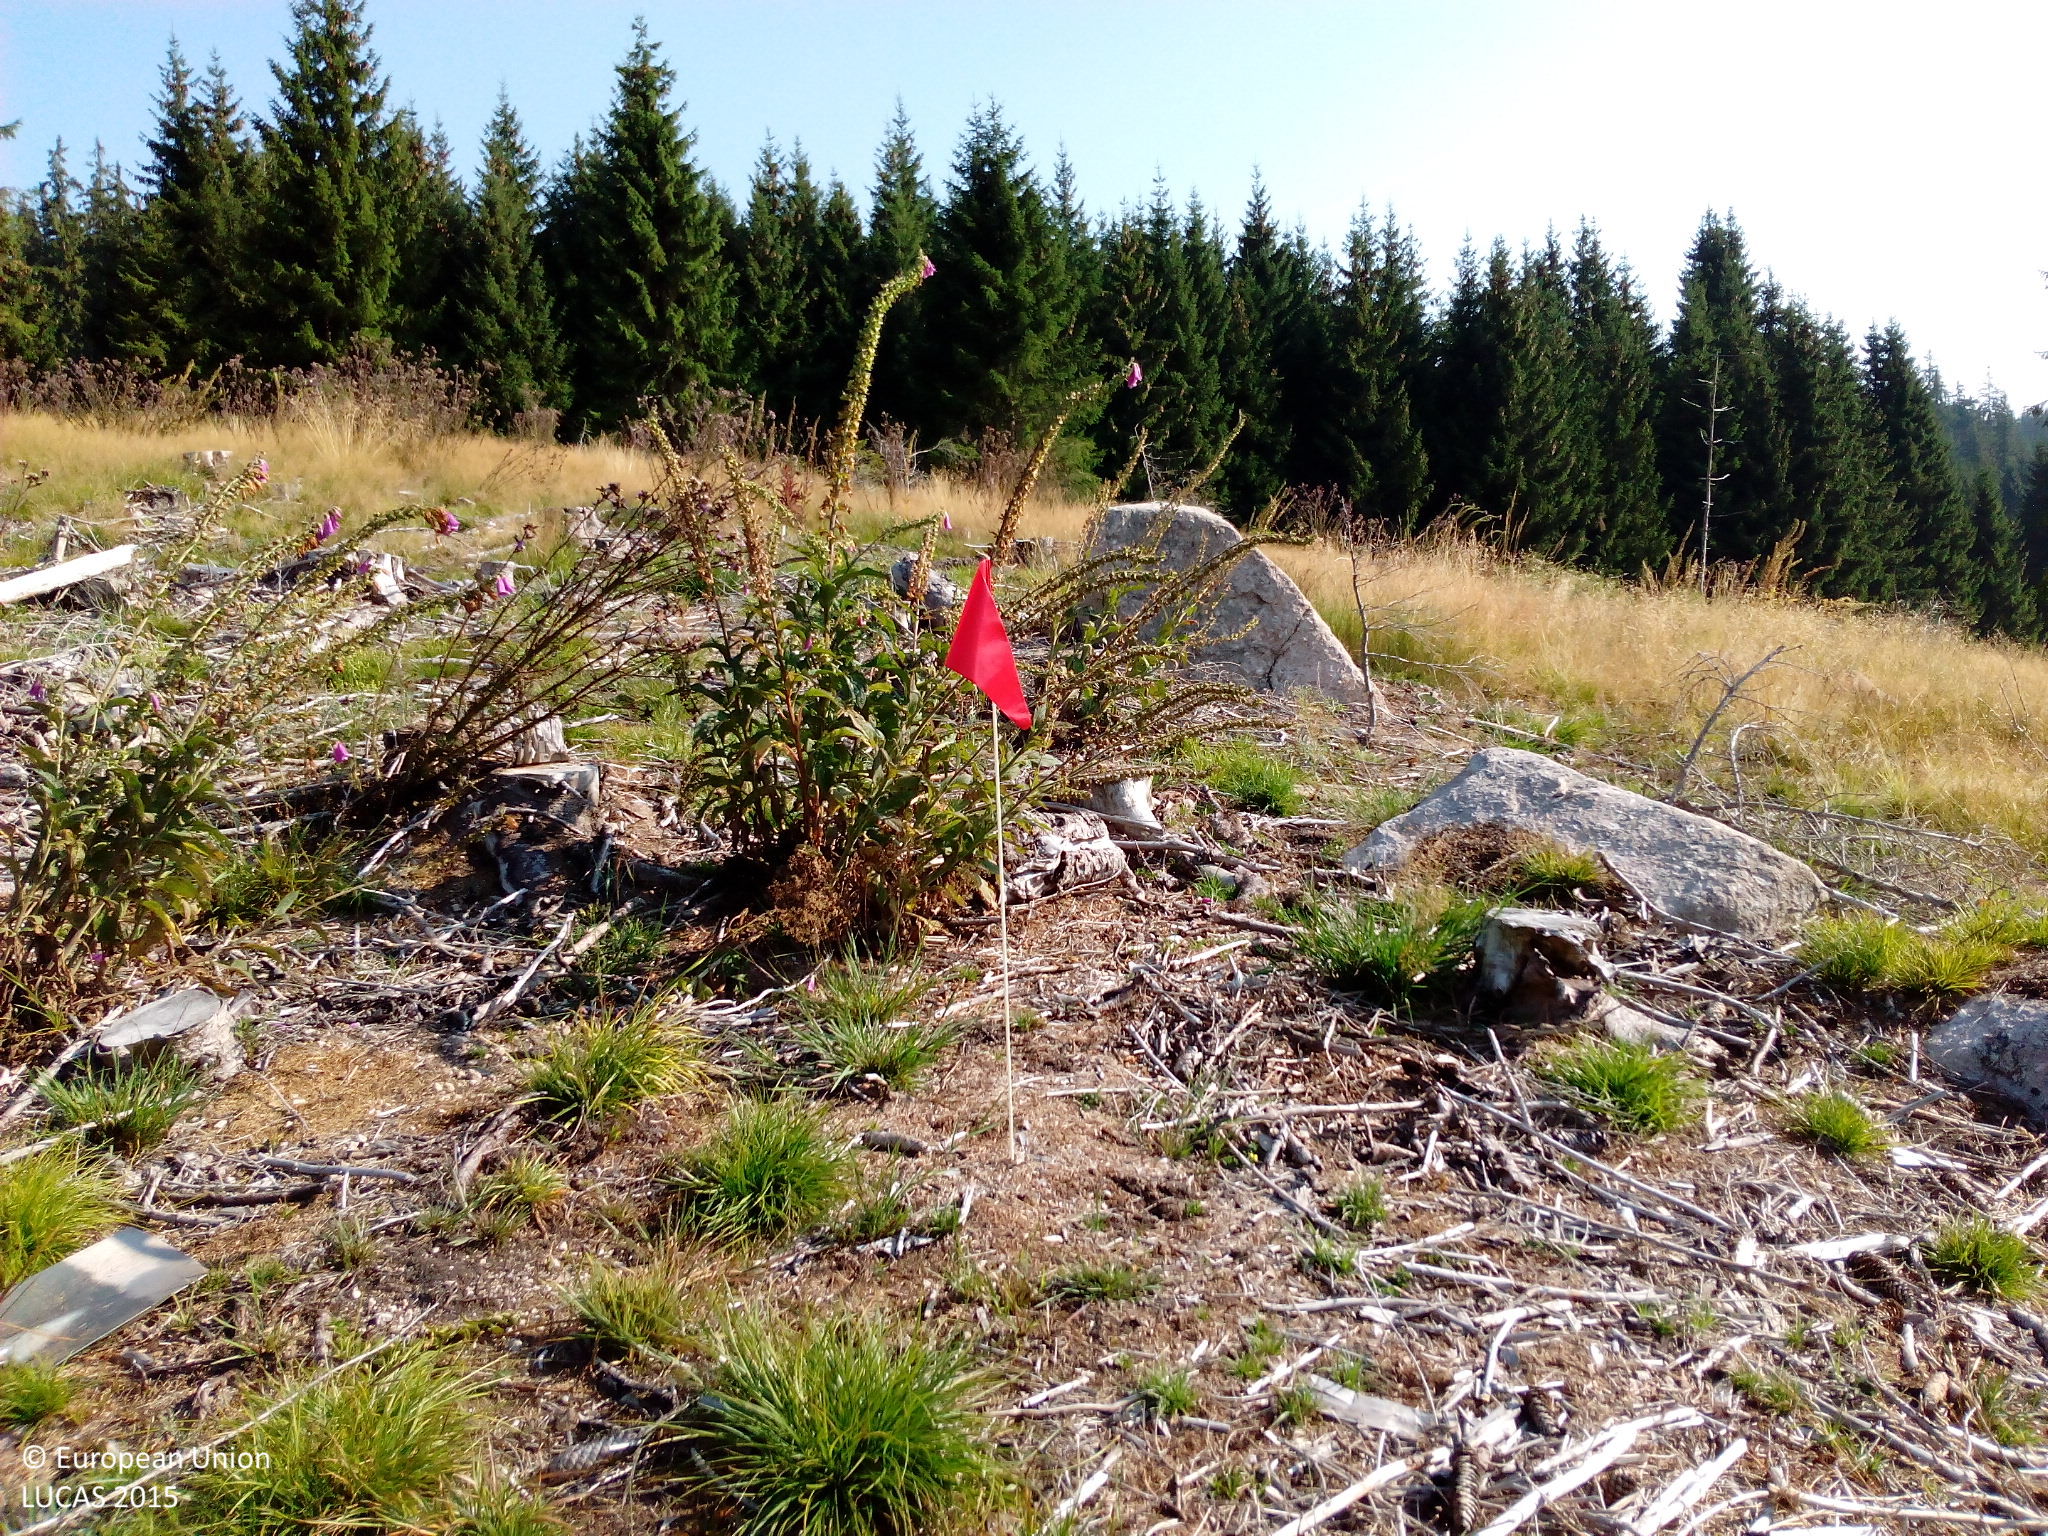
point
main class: Grassland
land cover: Spontaneously vegetated surfaces
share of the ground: 50 - 75 %
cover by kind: herbaceous plants 50 %, unconsolidated bare surface 50 %
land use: Forestry
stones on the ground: 10 - 25 %
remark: Clear cut
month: August
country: DE
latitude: 47.8115
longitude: 8.1183
